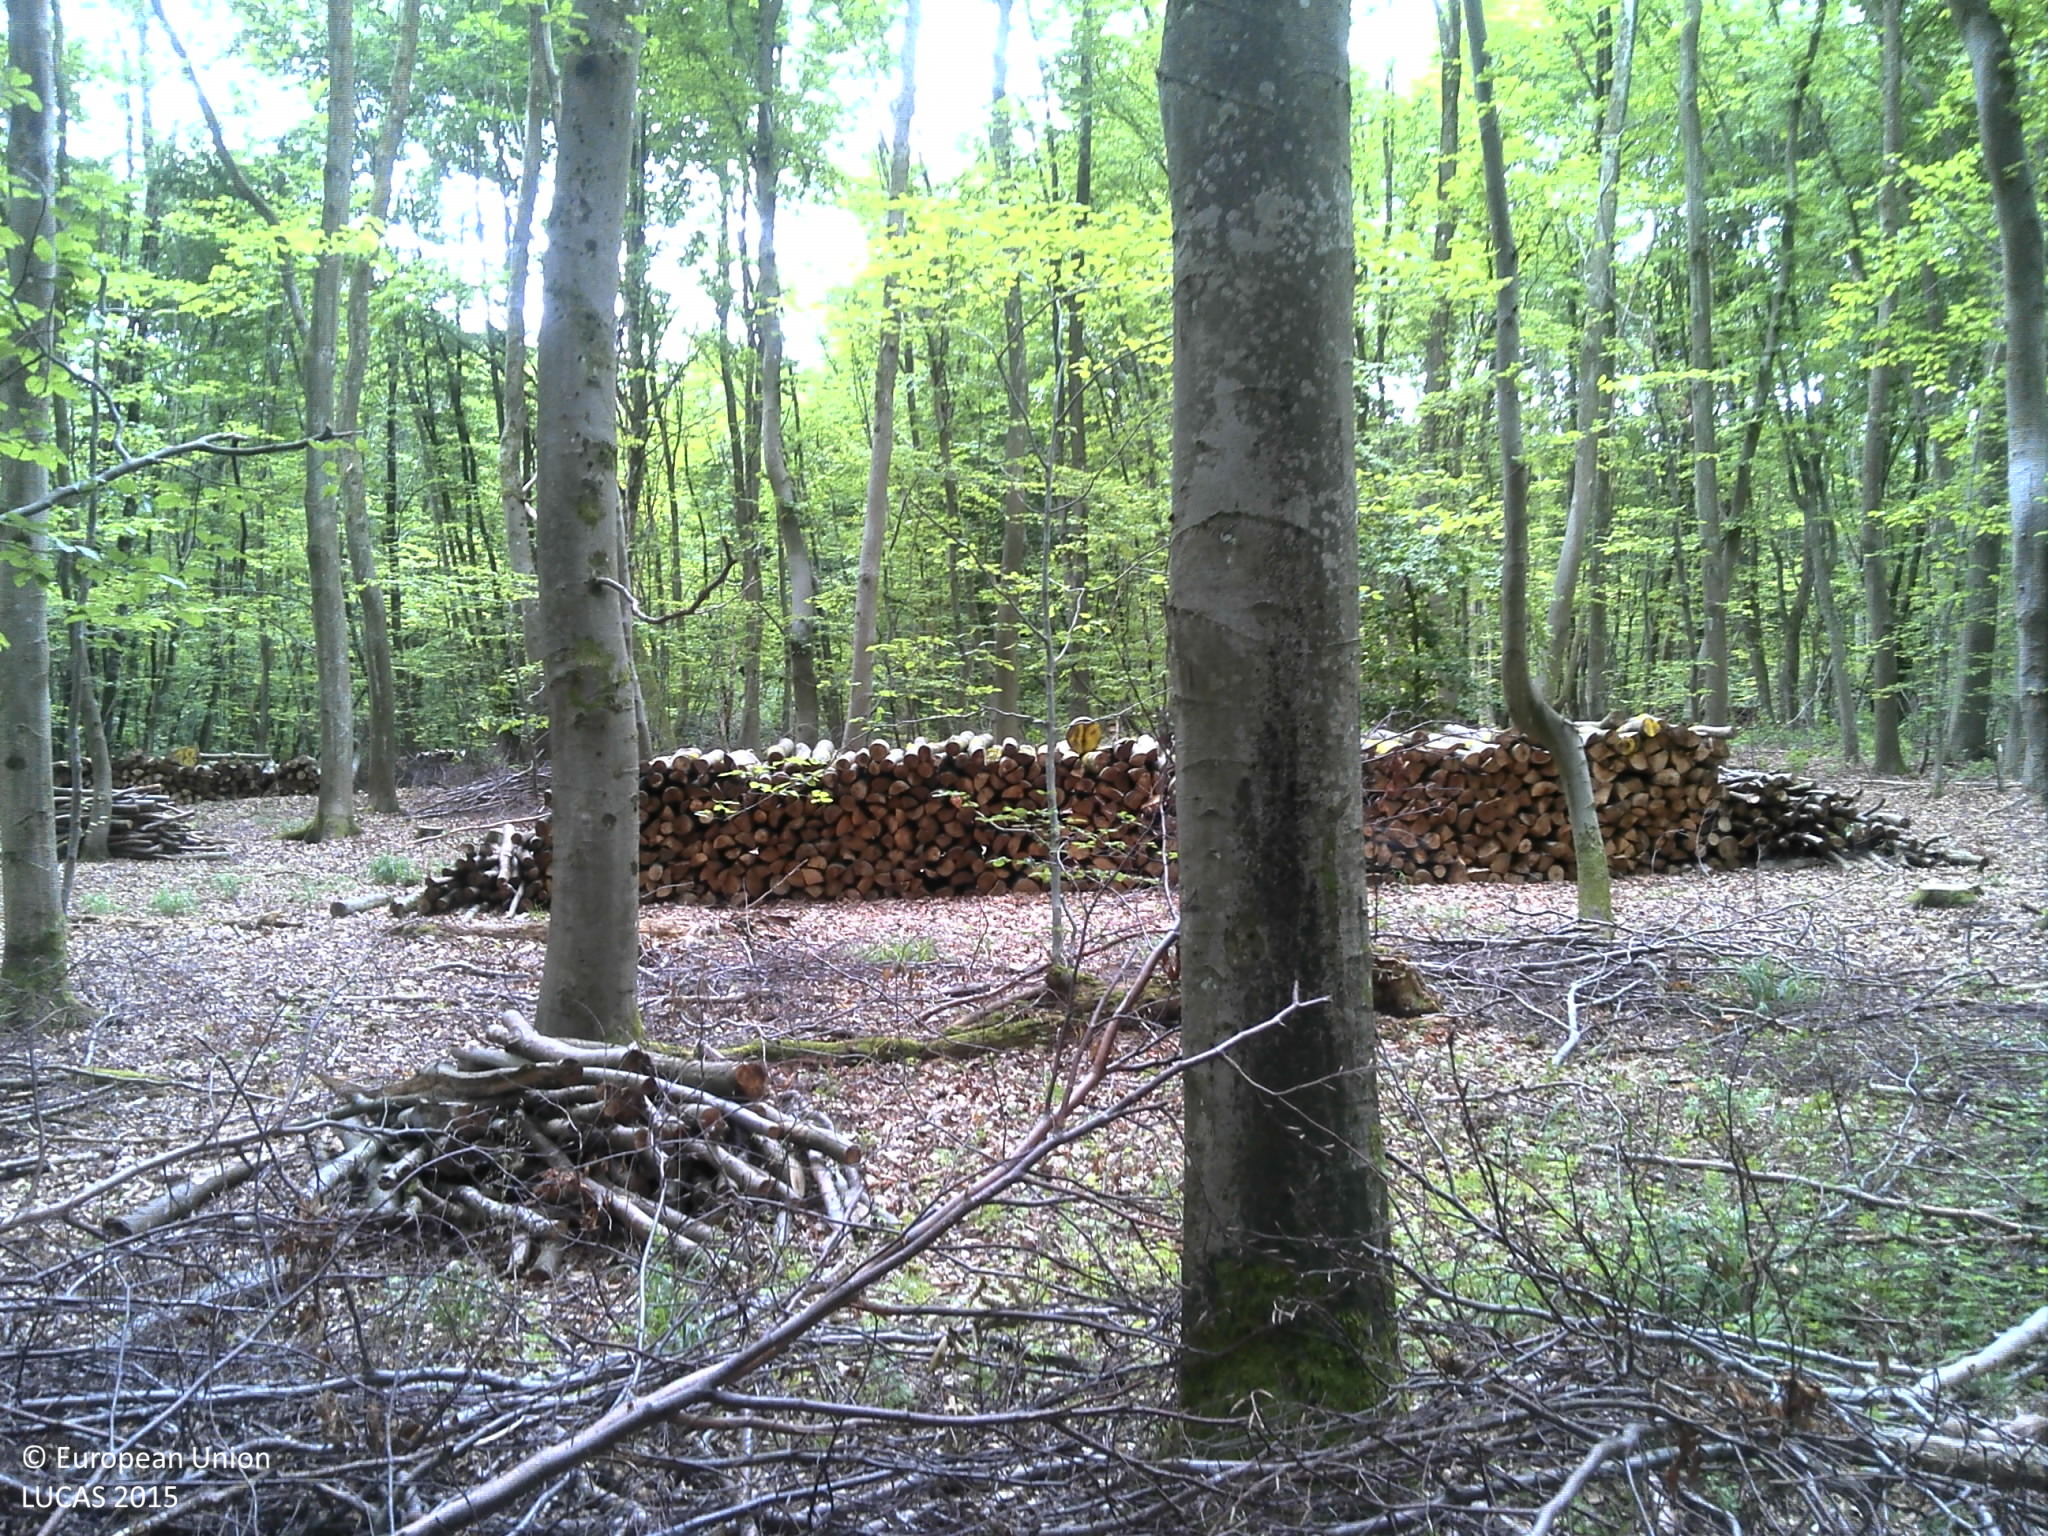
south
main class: Woodland
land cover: Broadleaved woodland
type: beech forest
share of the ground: > 75 %
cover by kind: broadleaved forest trees 100 %
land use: Forestry
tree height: > 5 m
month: July
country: FR
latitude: 49.3741
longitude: 6.4879
